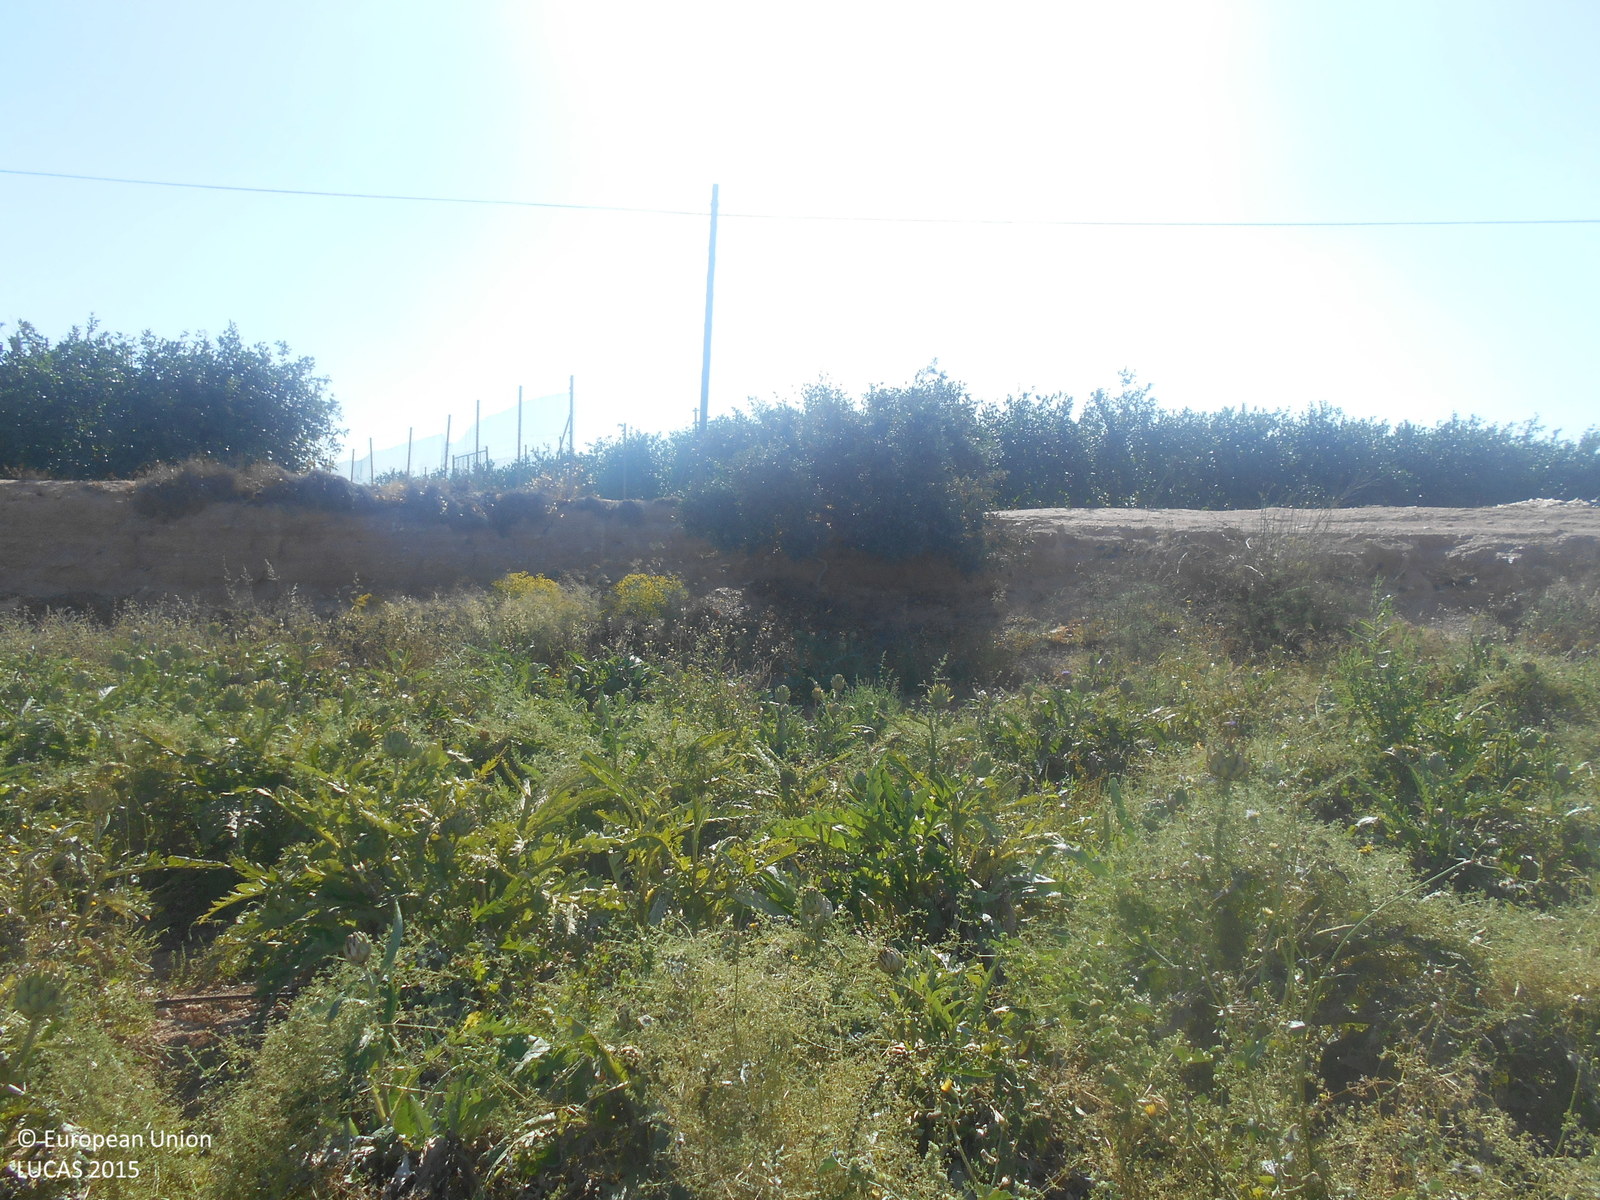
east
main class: Cropland
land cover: Other fresh vegetables
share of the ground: 25 - 50 %
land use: Agriculture (excluding fallow land and kitchen gardens)
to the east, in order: Other fresh vegetables; Shruby margins; Single bushes/trees; Tracks; Other citrus fruit; Electric lines; Other citrus fruit; Fences; Paved roads, cycling and walking lanes; Fences; Other citrus fruit
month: May
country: ES
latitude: 37.7551
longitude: -0.9332
